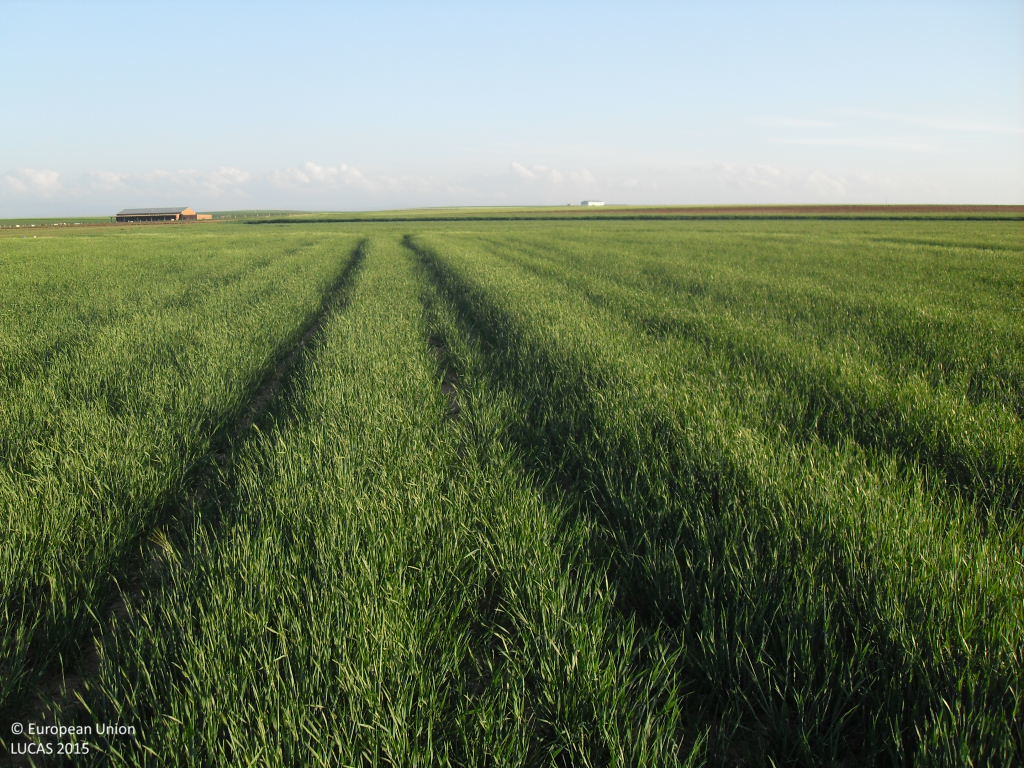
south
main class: Cropland
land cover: Barley
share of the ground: > 75 %
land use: Agriculture (excluding fallow land and kitchen gardens)
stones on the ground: < 10 %
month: May
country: ES
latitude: 40.8648
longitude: -5.2664
